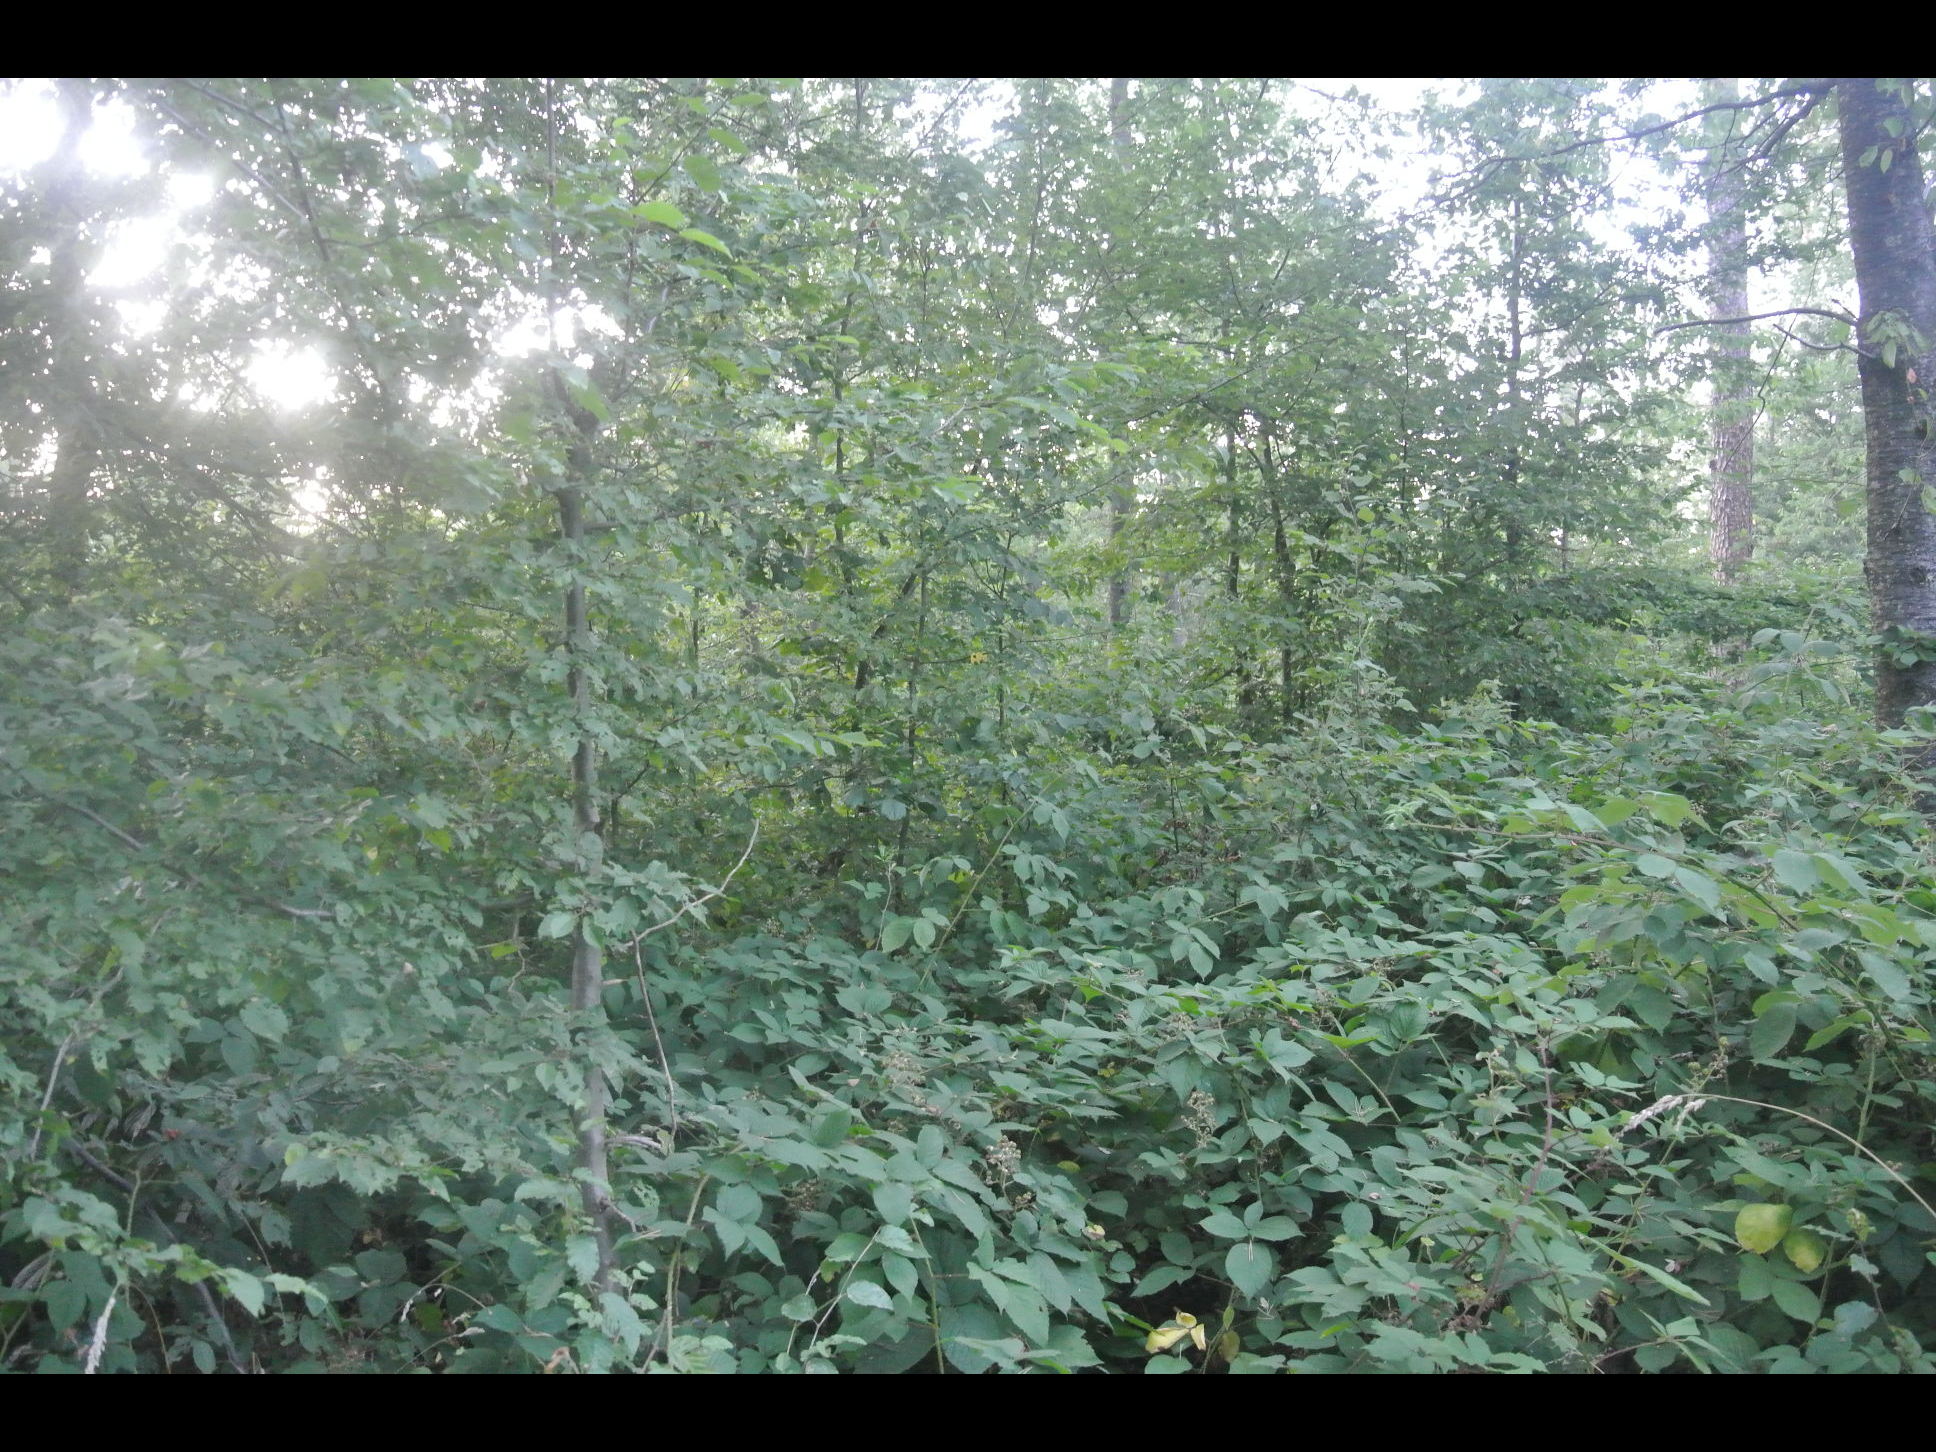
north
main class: Woodland
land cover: Pine dominated mixed woodland
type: alpine coniferous forest
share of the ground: > 75 %
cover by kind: broadleaved forest trees 75 %, coniferous forest trees 25 %
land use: Forestry
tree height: > 5 m
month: July
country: AT
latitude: 47.5832
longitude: 16.4525
